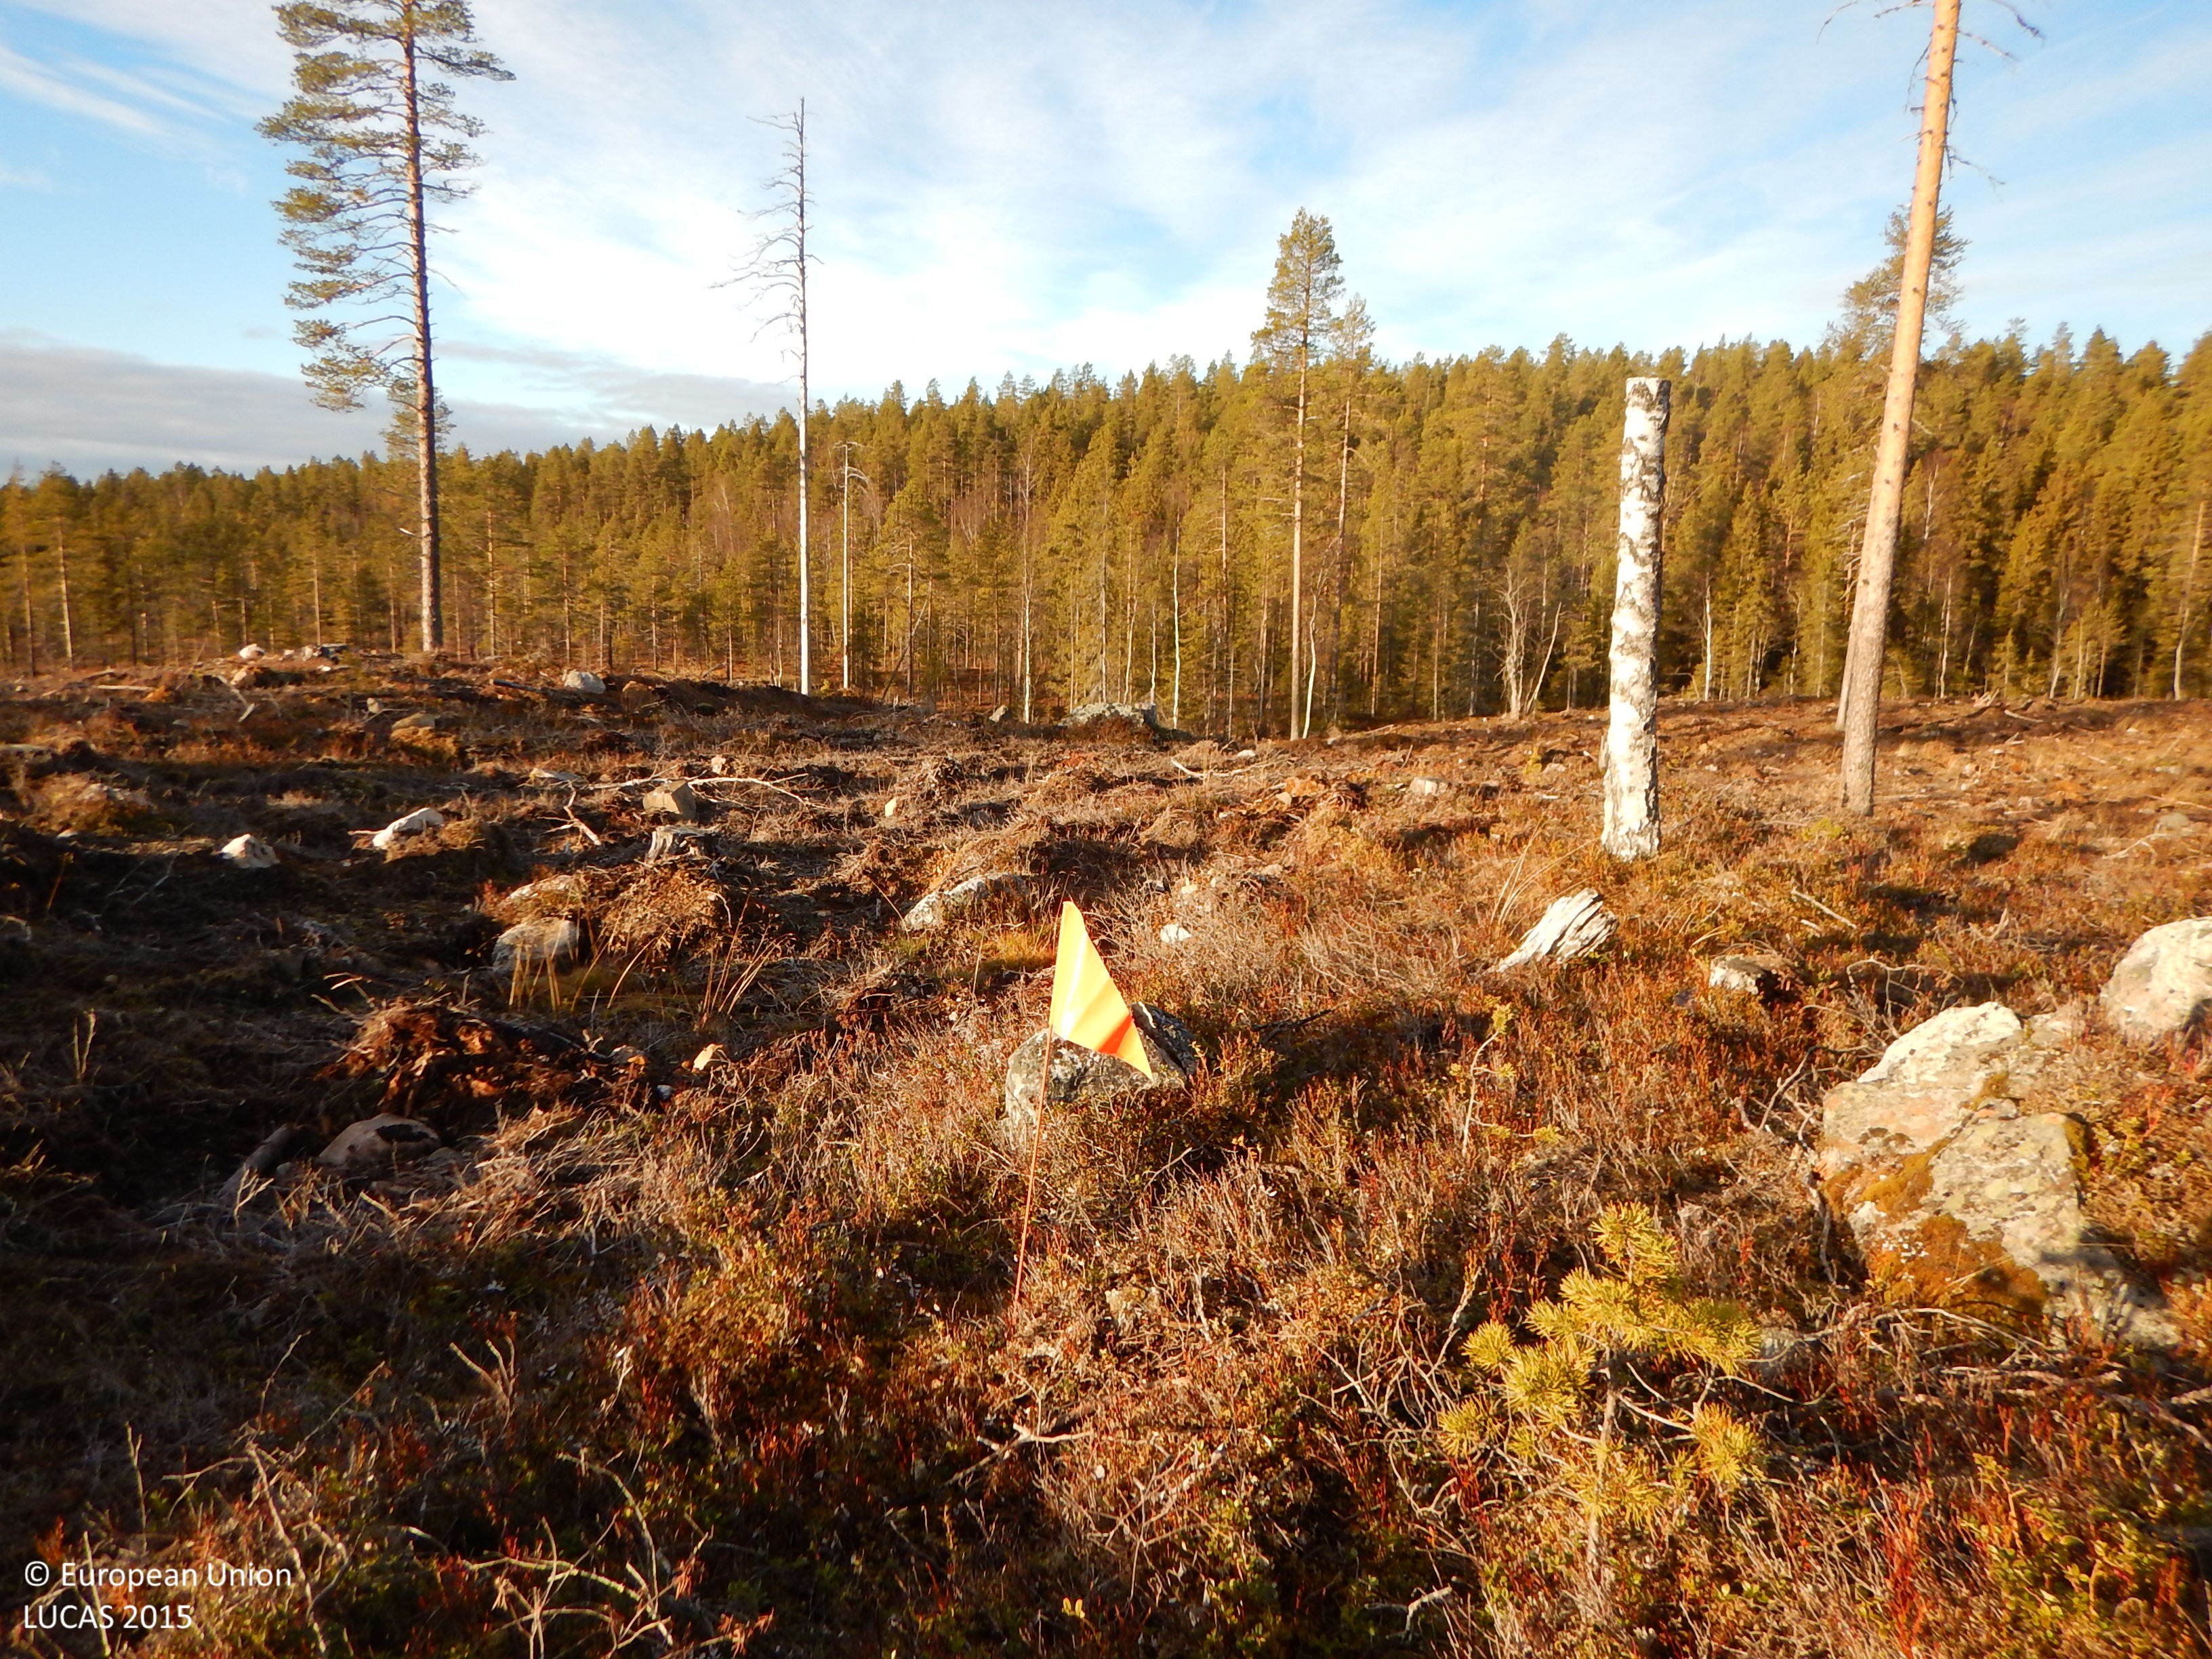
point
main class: Shrubland
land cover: Shrubland with sparse tree cover
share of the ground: 50 - 75 %
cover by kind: shrubs 50 %, herbaceous plants 20 %, lichens and mosses 15 %, coniferous forest trees 5 %, consolidated bare surface 5 %, unconsolidated bare surface 5 %
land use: Forestry
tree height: < 5 m
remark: Clear cut
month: November
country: SE
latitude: 65.3389
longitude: 20.6015
